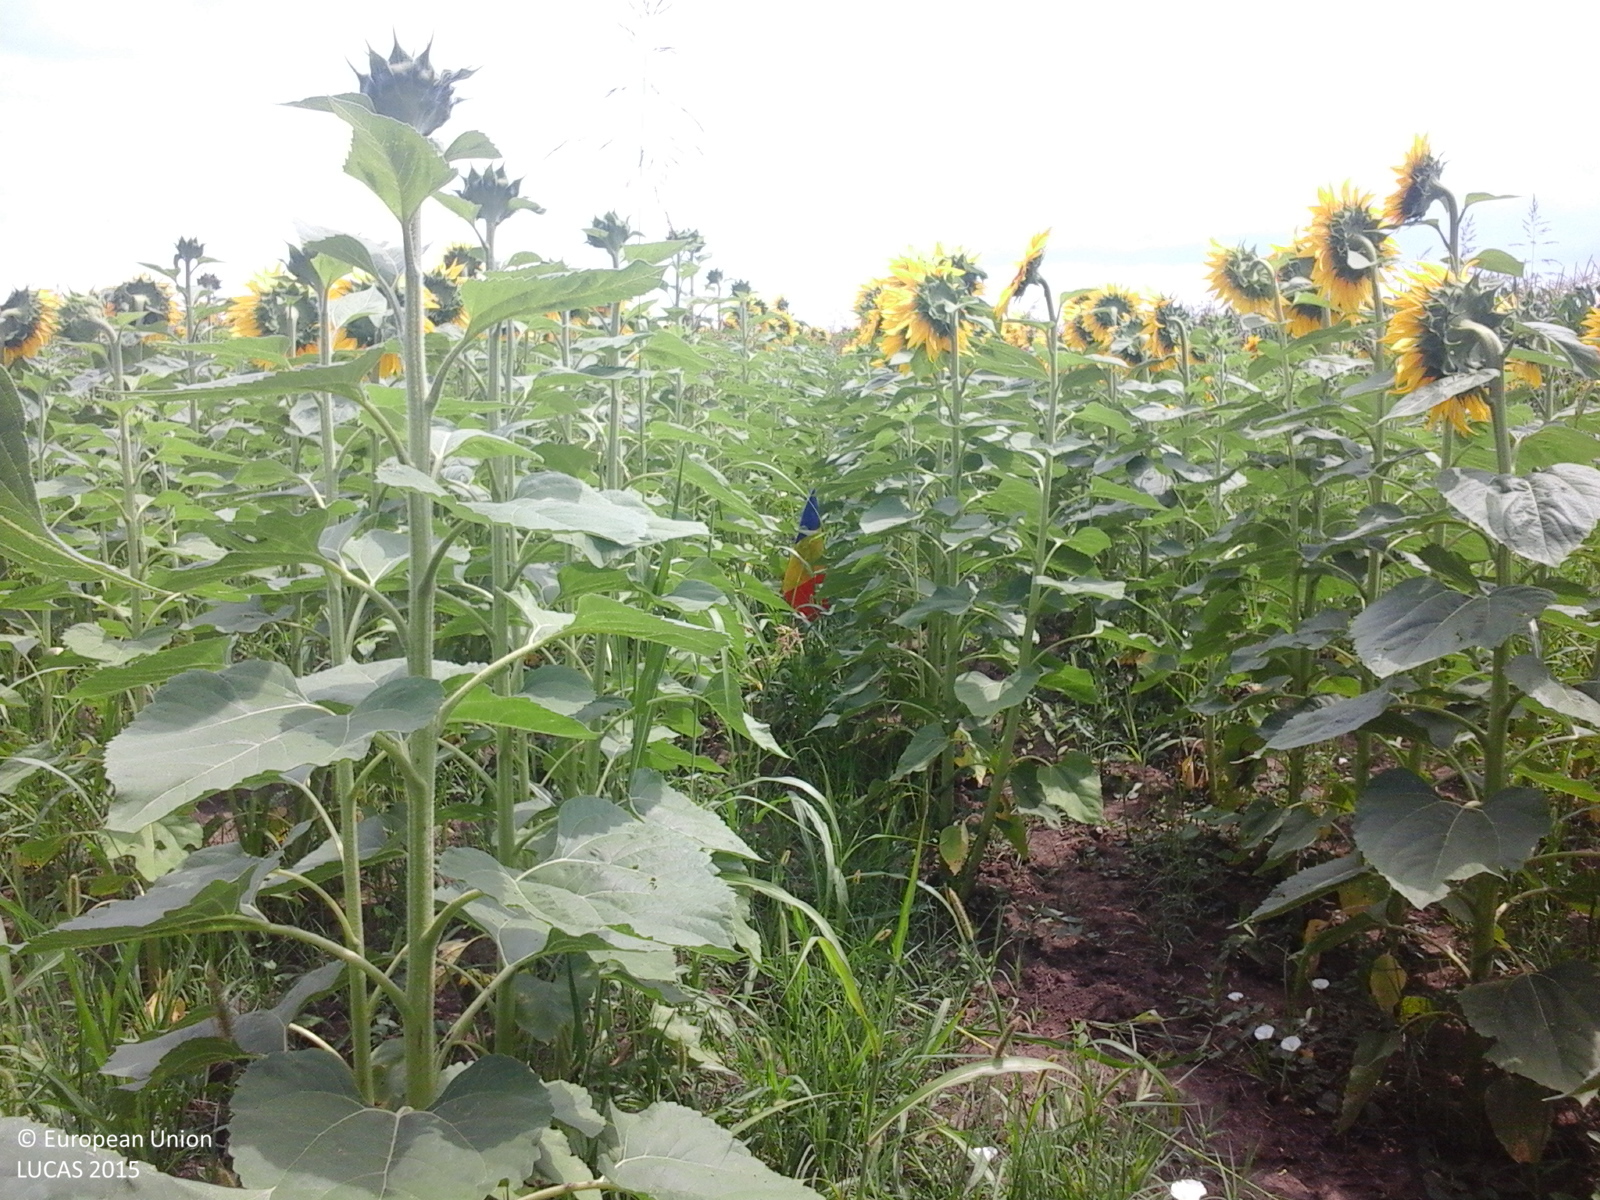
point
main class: Cropland
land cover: Sunflower
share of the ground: > 75 %
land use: Agriculture (excluding fallow land and kitchen gardens)
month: July
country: RO
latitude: 44.0070
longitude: 24.4716
